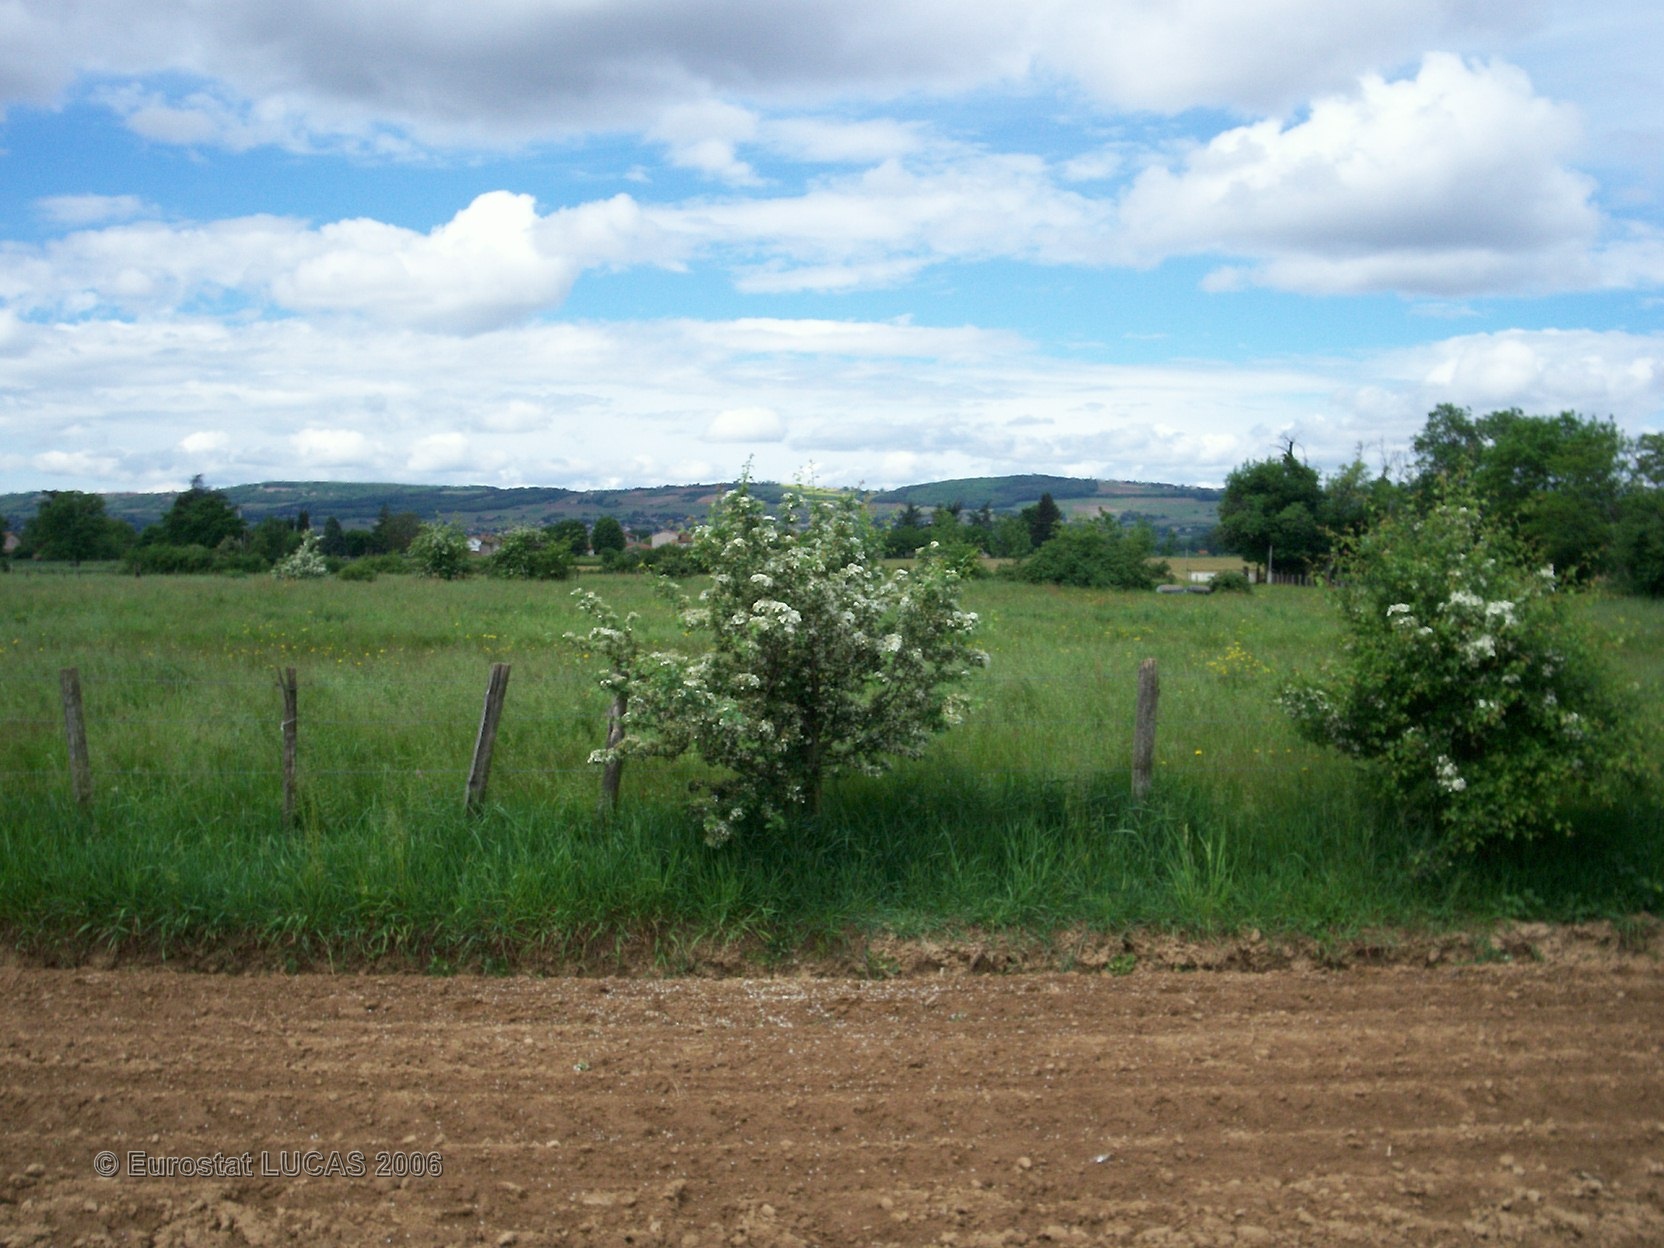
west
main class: Cropland
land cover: Maize
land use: Agriculture (excluding fallow land and kitchen gardens)
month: May
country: FR
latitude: 45.9157
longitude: 4.7557
